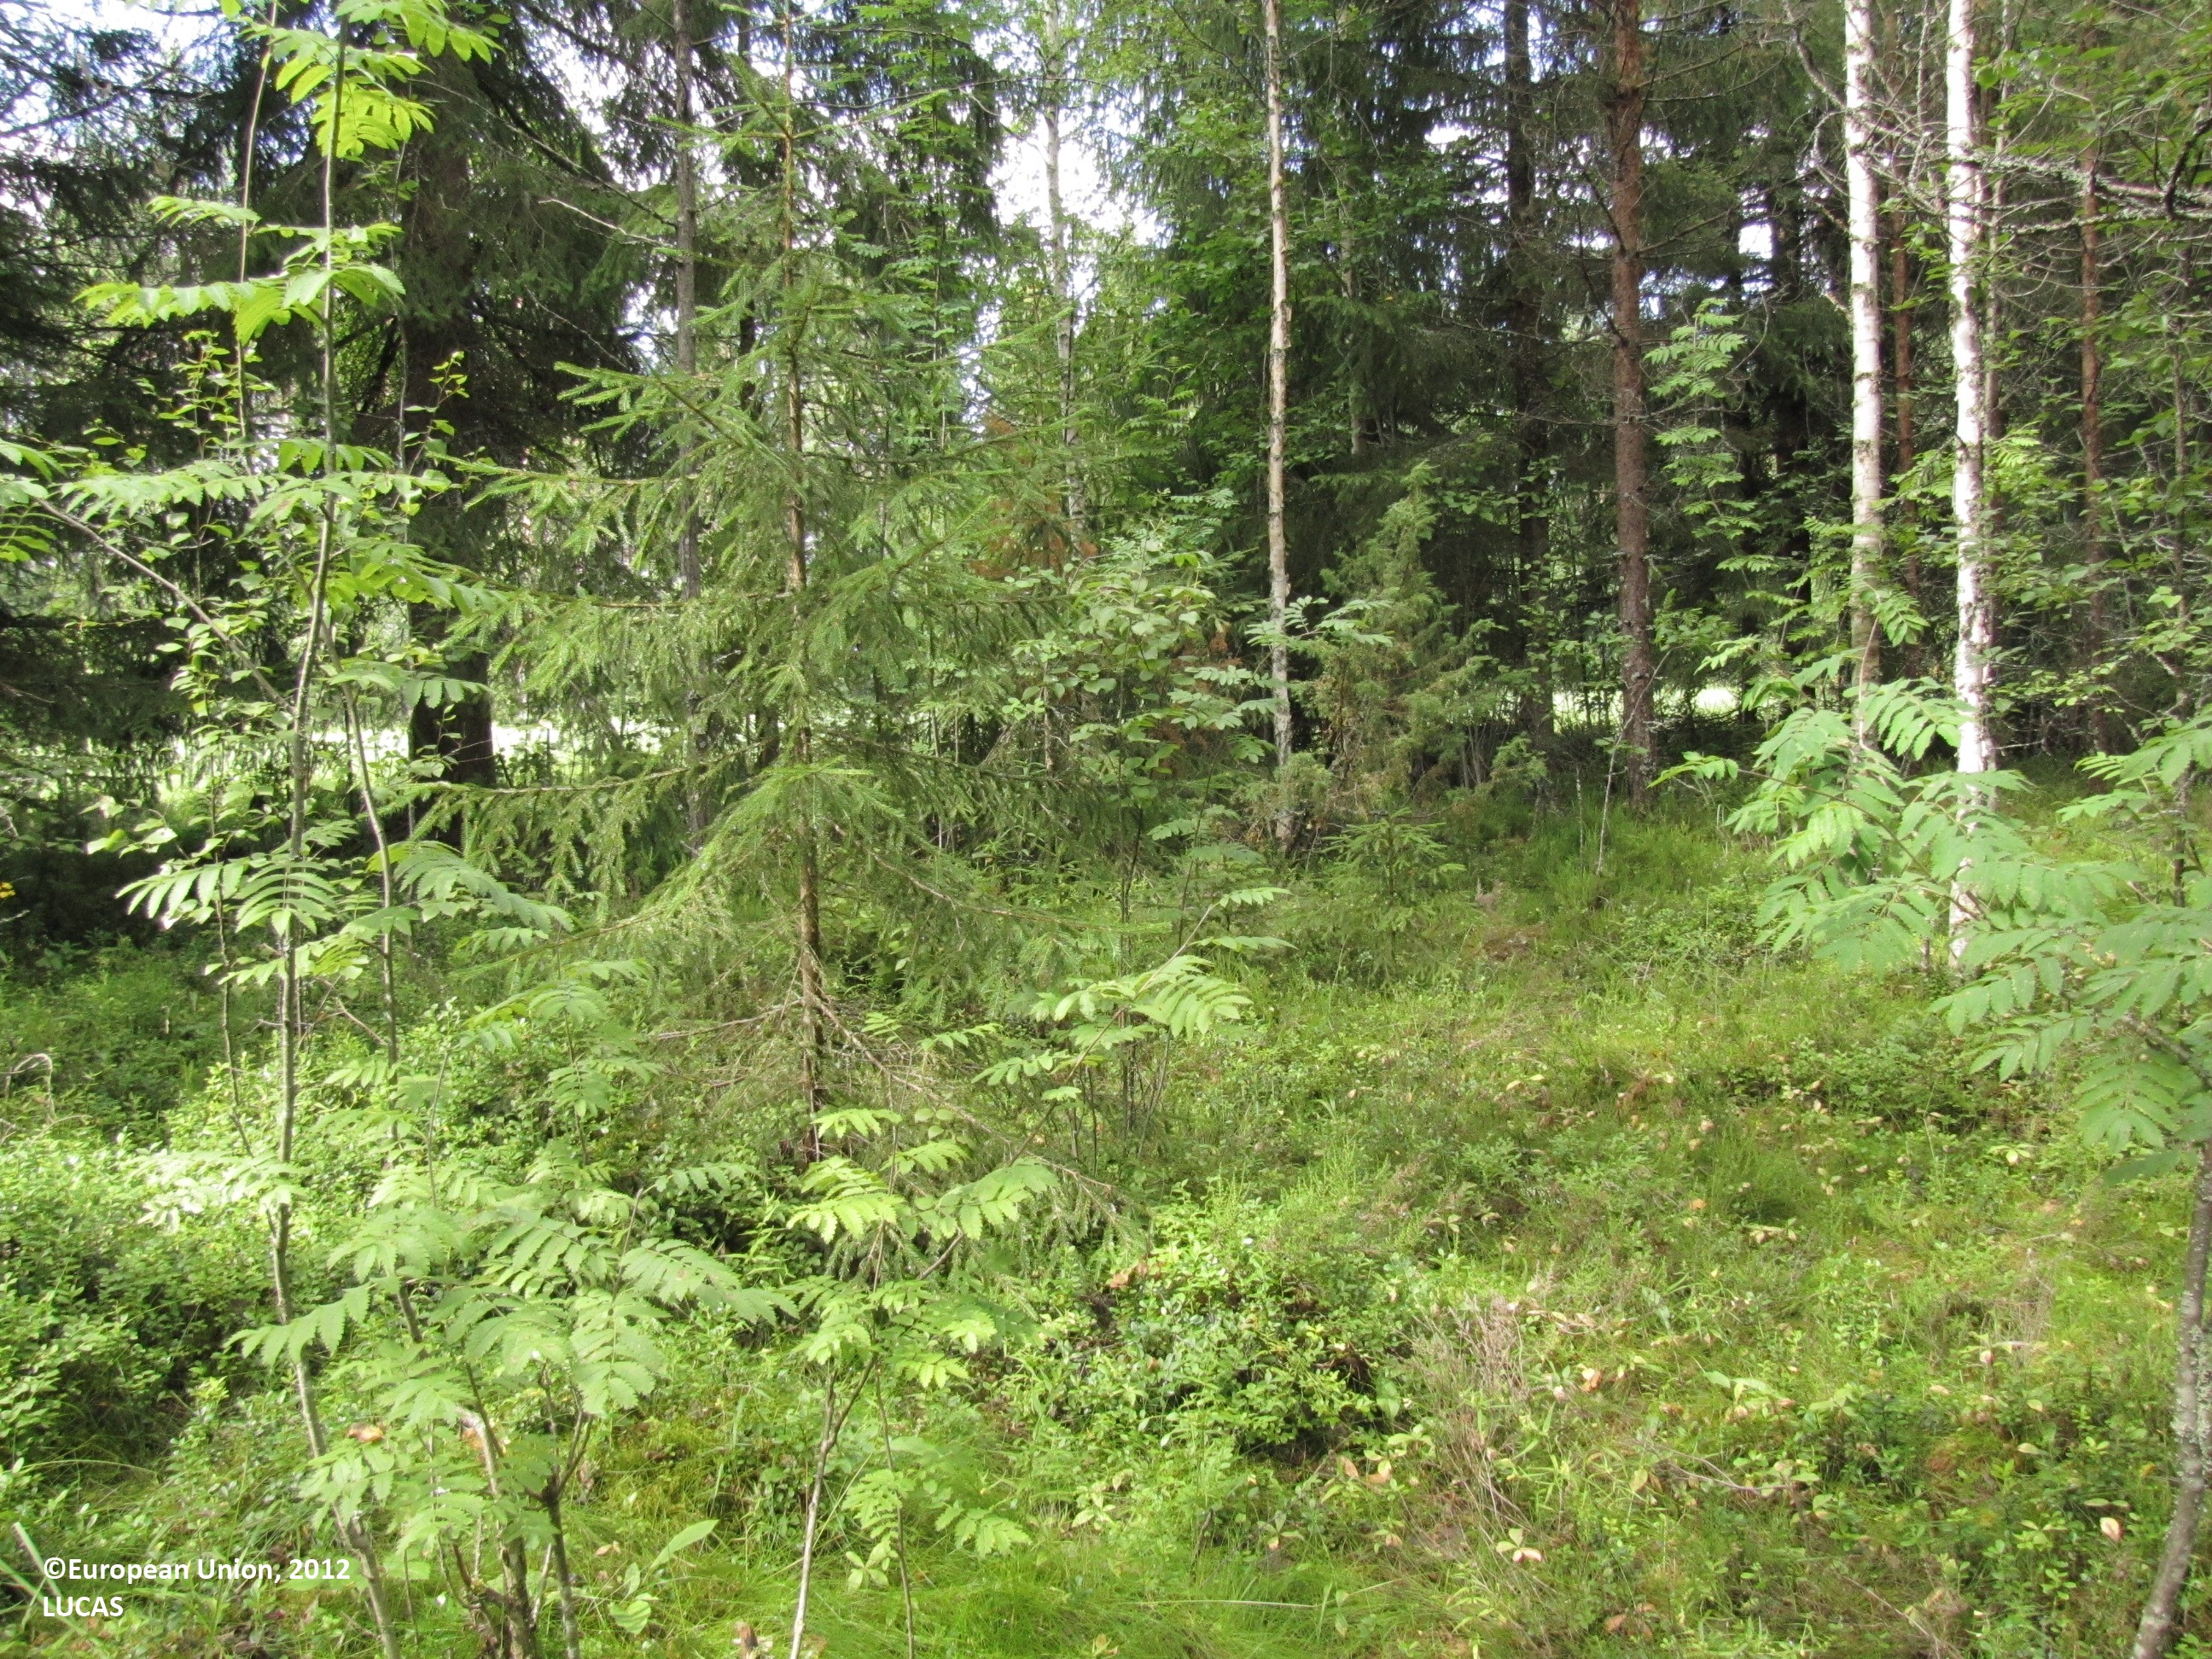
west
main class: Woodland
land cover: Other mixed woodland
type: boreal forest
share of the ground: 50 - 75 %
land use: Forestry
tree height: > 5 m
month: July
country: FI
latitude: 62.2499
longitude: 23.1782
